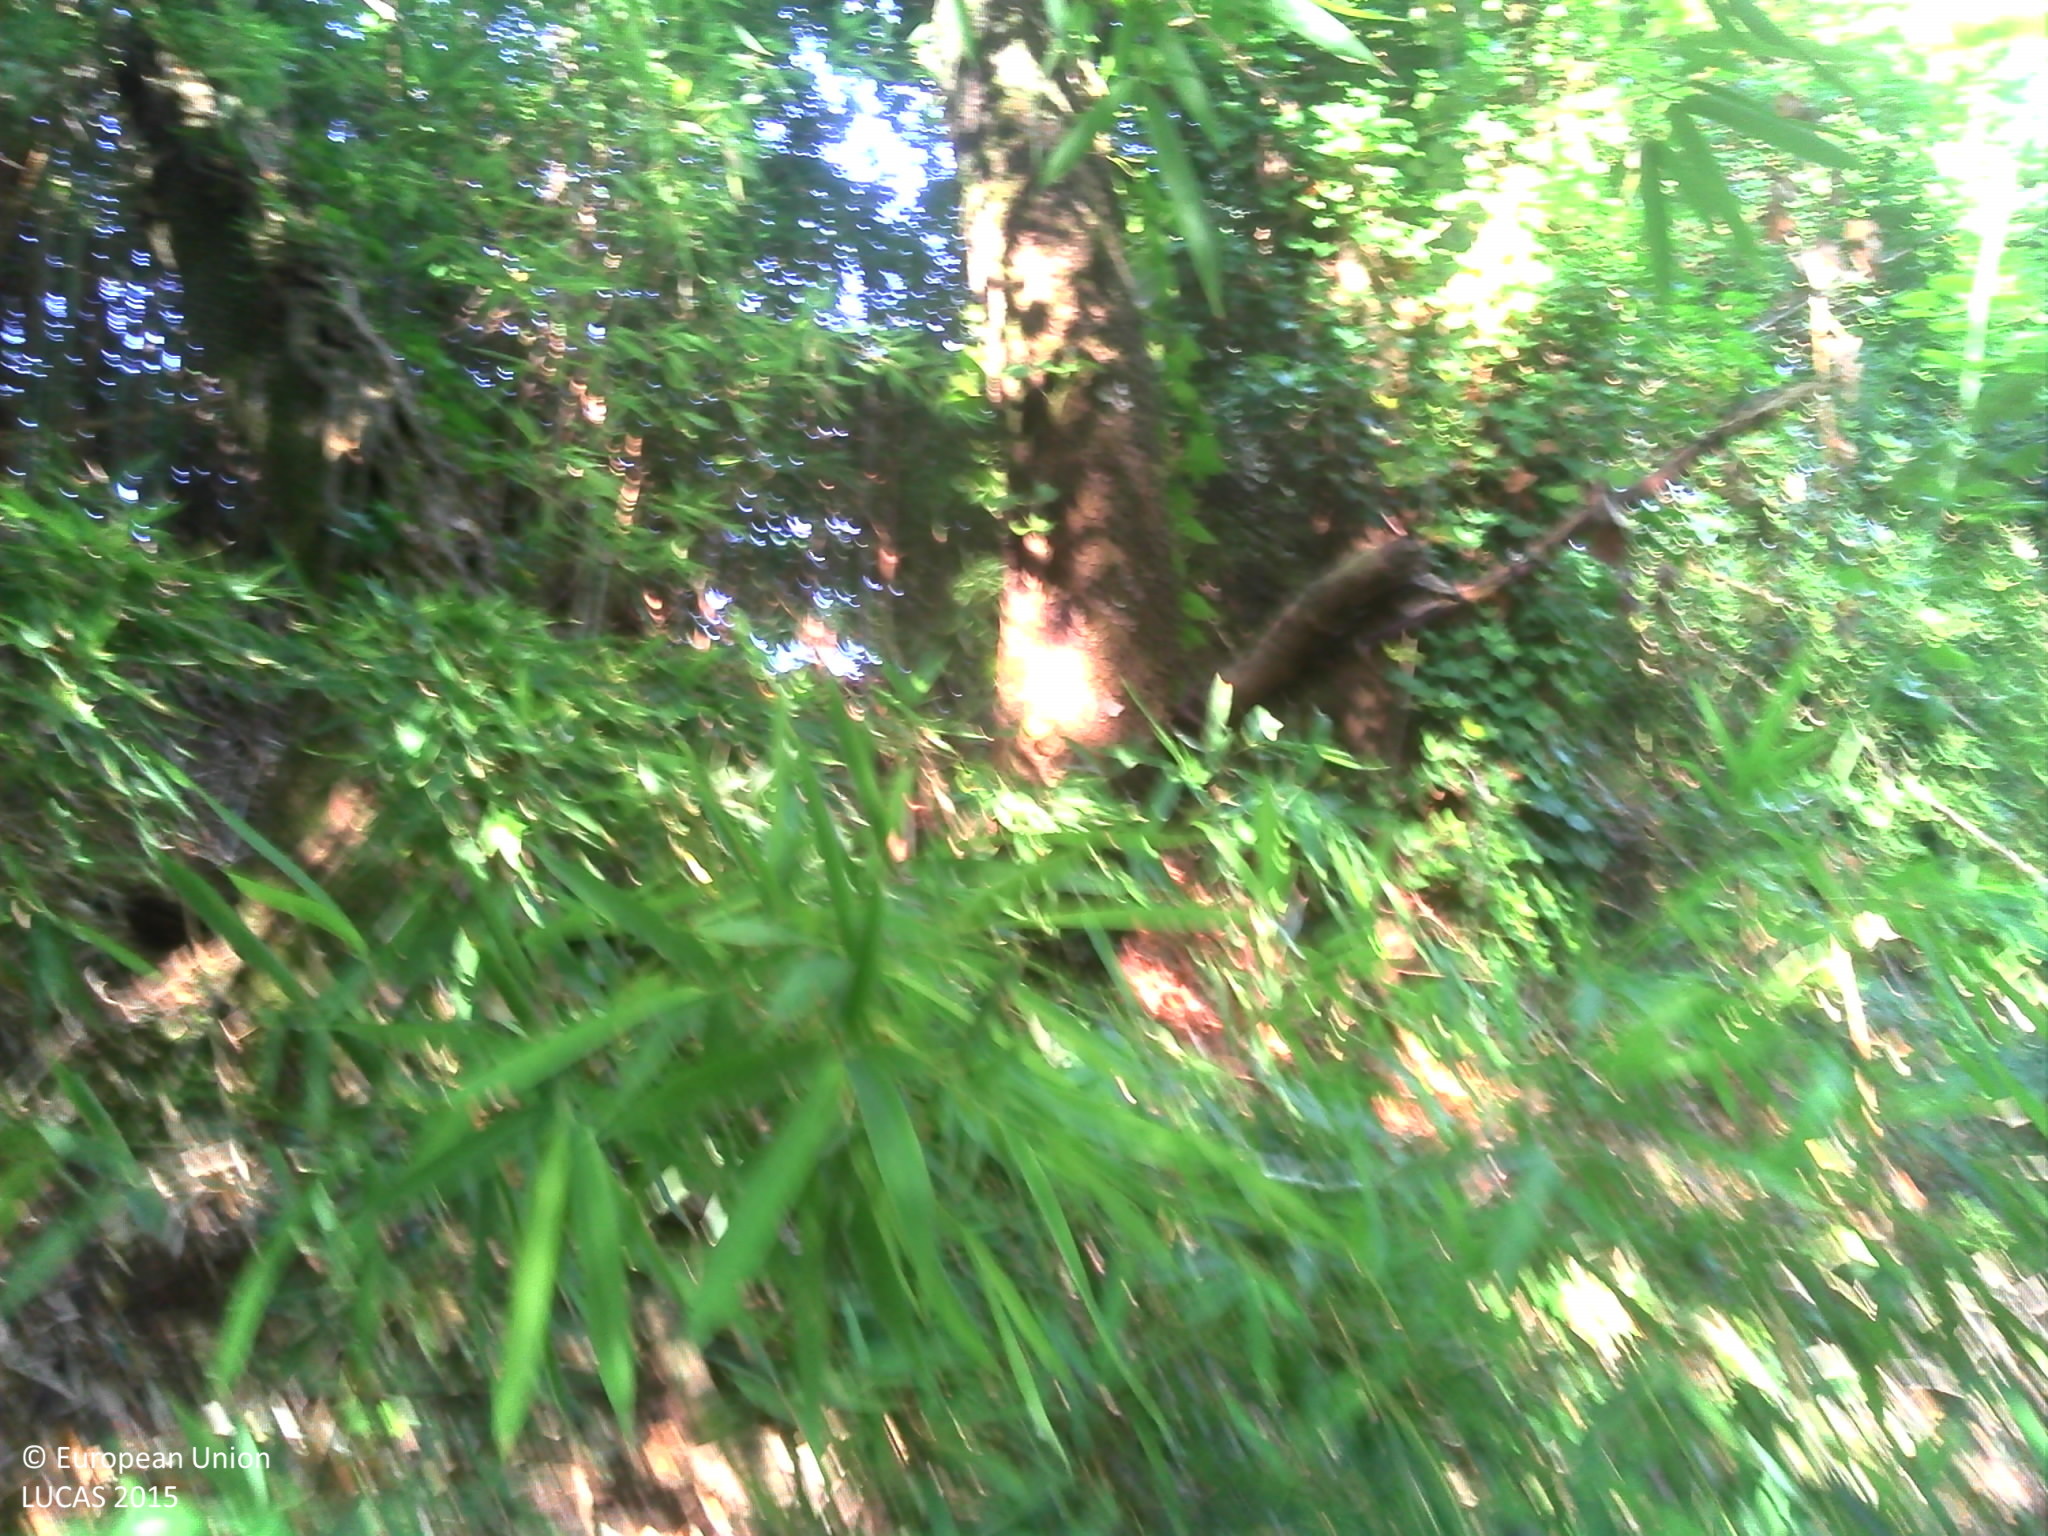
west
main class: Woodland
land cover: Broadleaved woodland
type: boreal forest
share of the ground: > 75 %
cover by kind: broadleaved forest trees 90 %, shrubs 10 %
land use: Semi-natural and natural areas not in use
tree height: > 5 m
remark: Temporary flooded
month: July
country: FR
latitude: 43.3840
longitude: 6.3675
